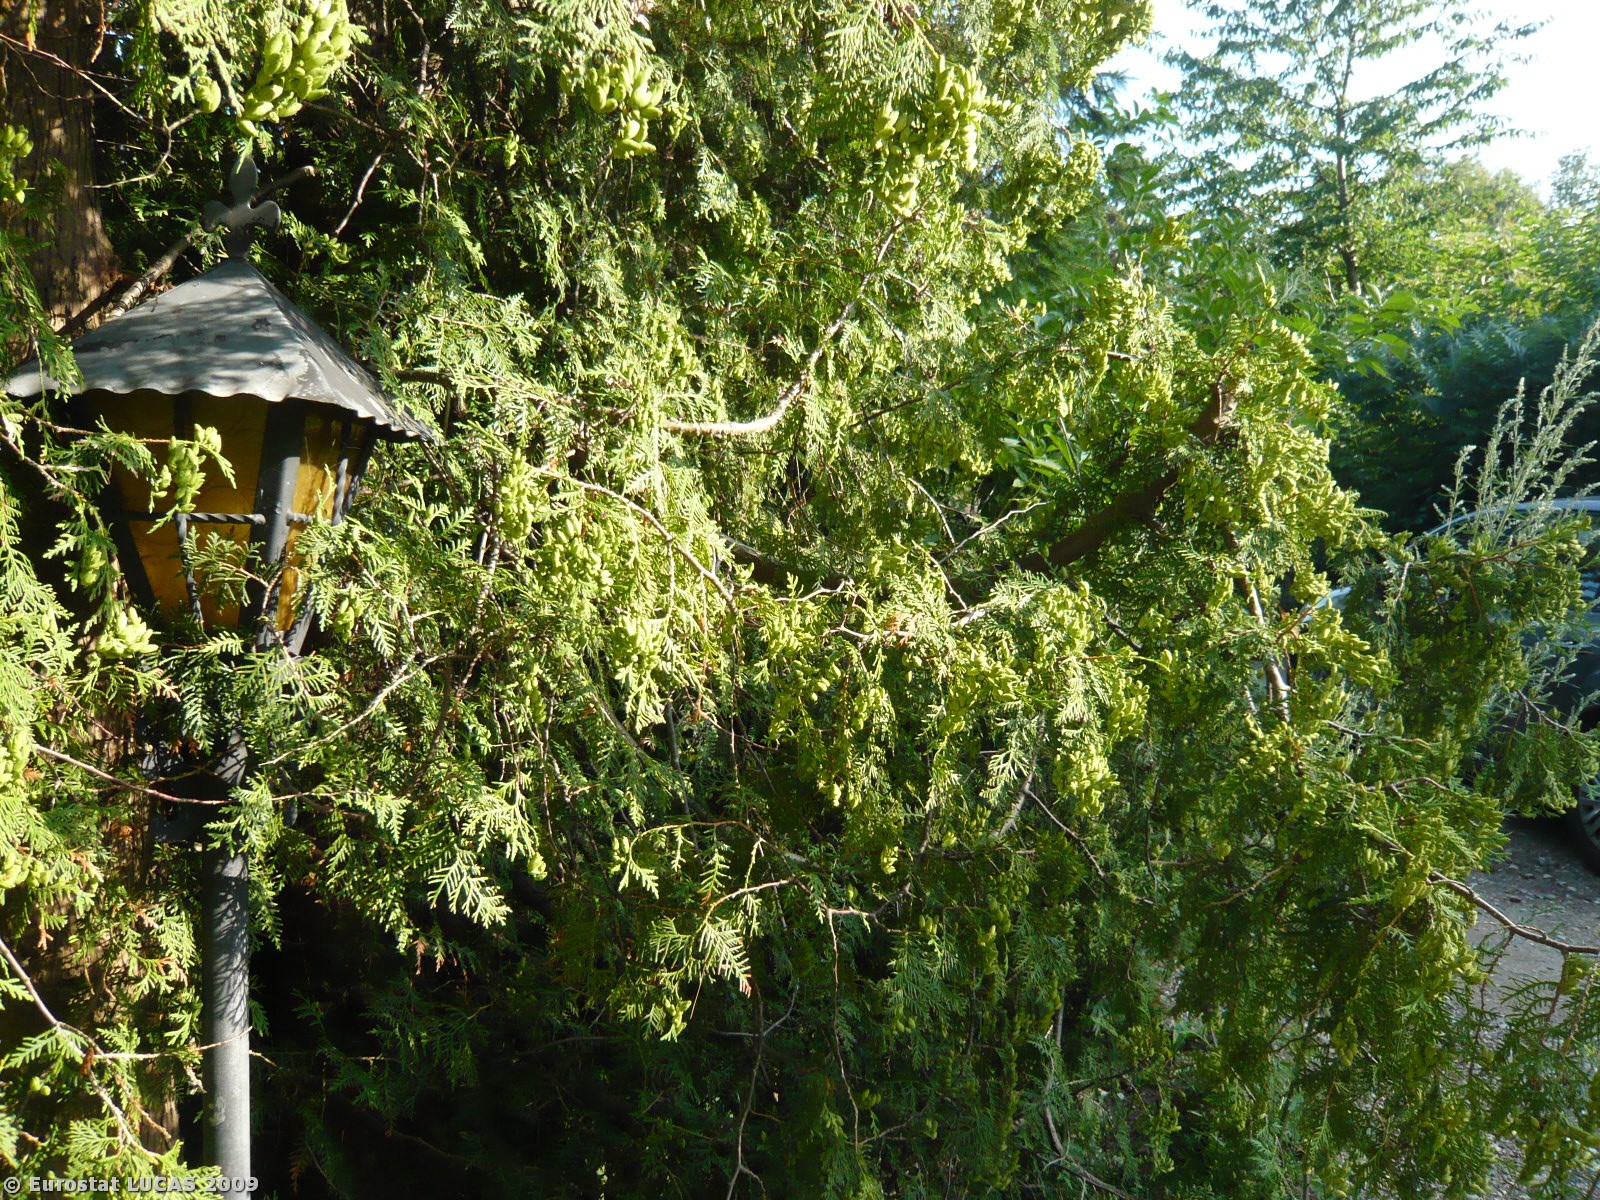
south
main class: Woodland
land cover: Coniferous woodland
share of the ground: > 75 %
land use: Holiday camps
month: July
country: DK
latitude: 55.7997
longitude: 11.6415
